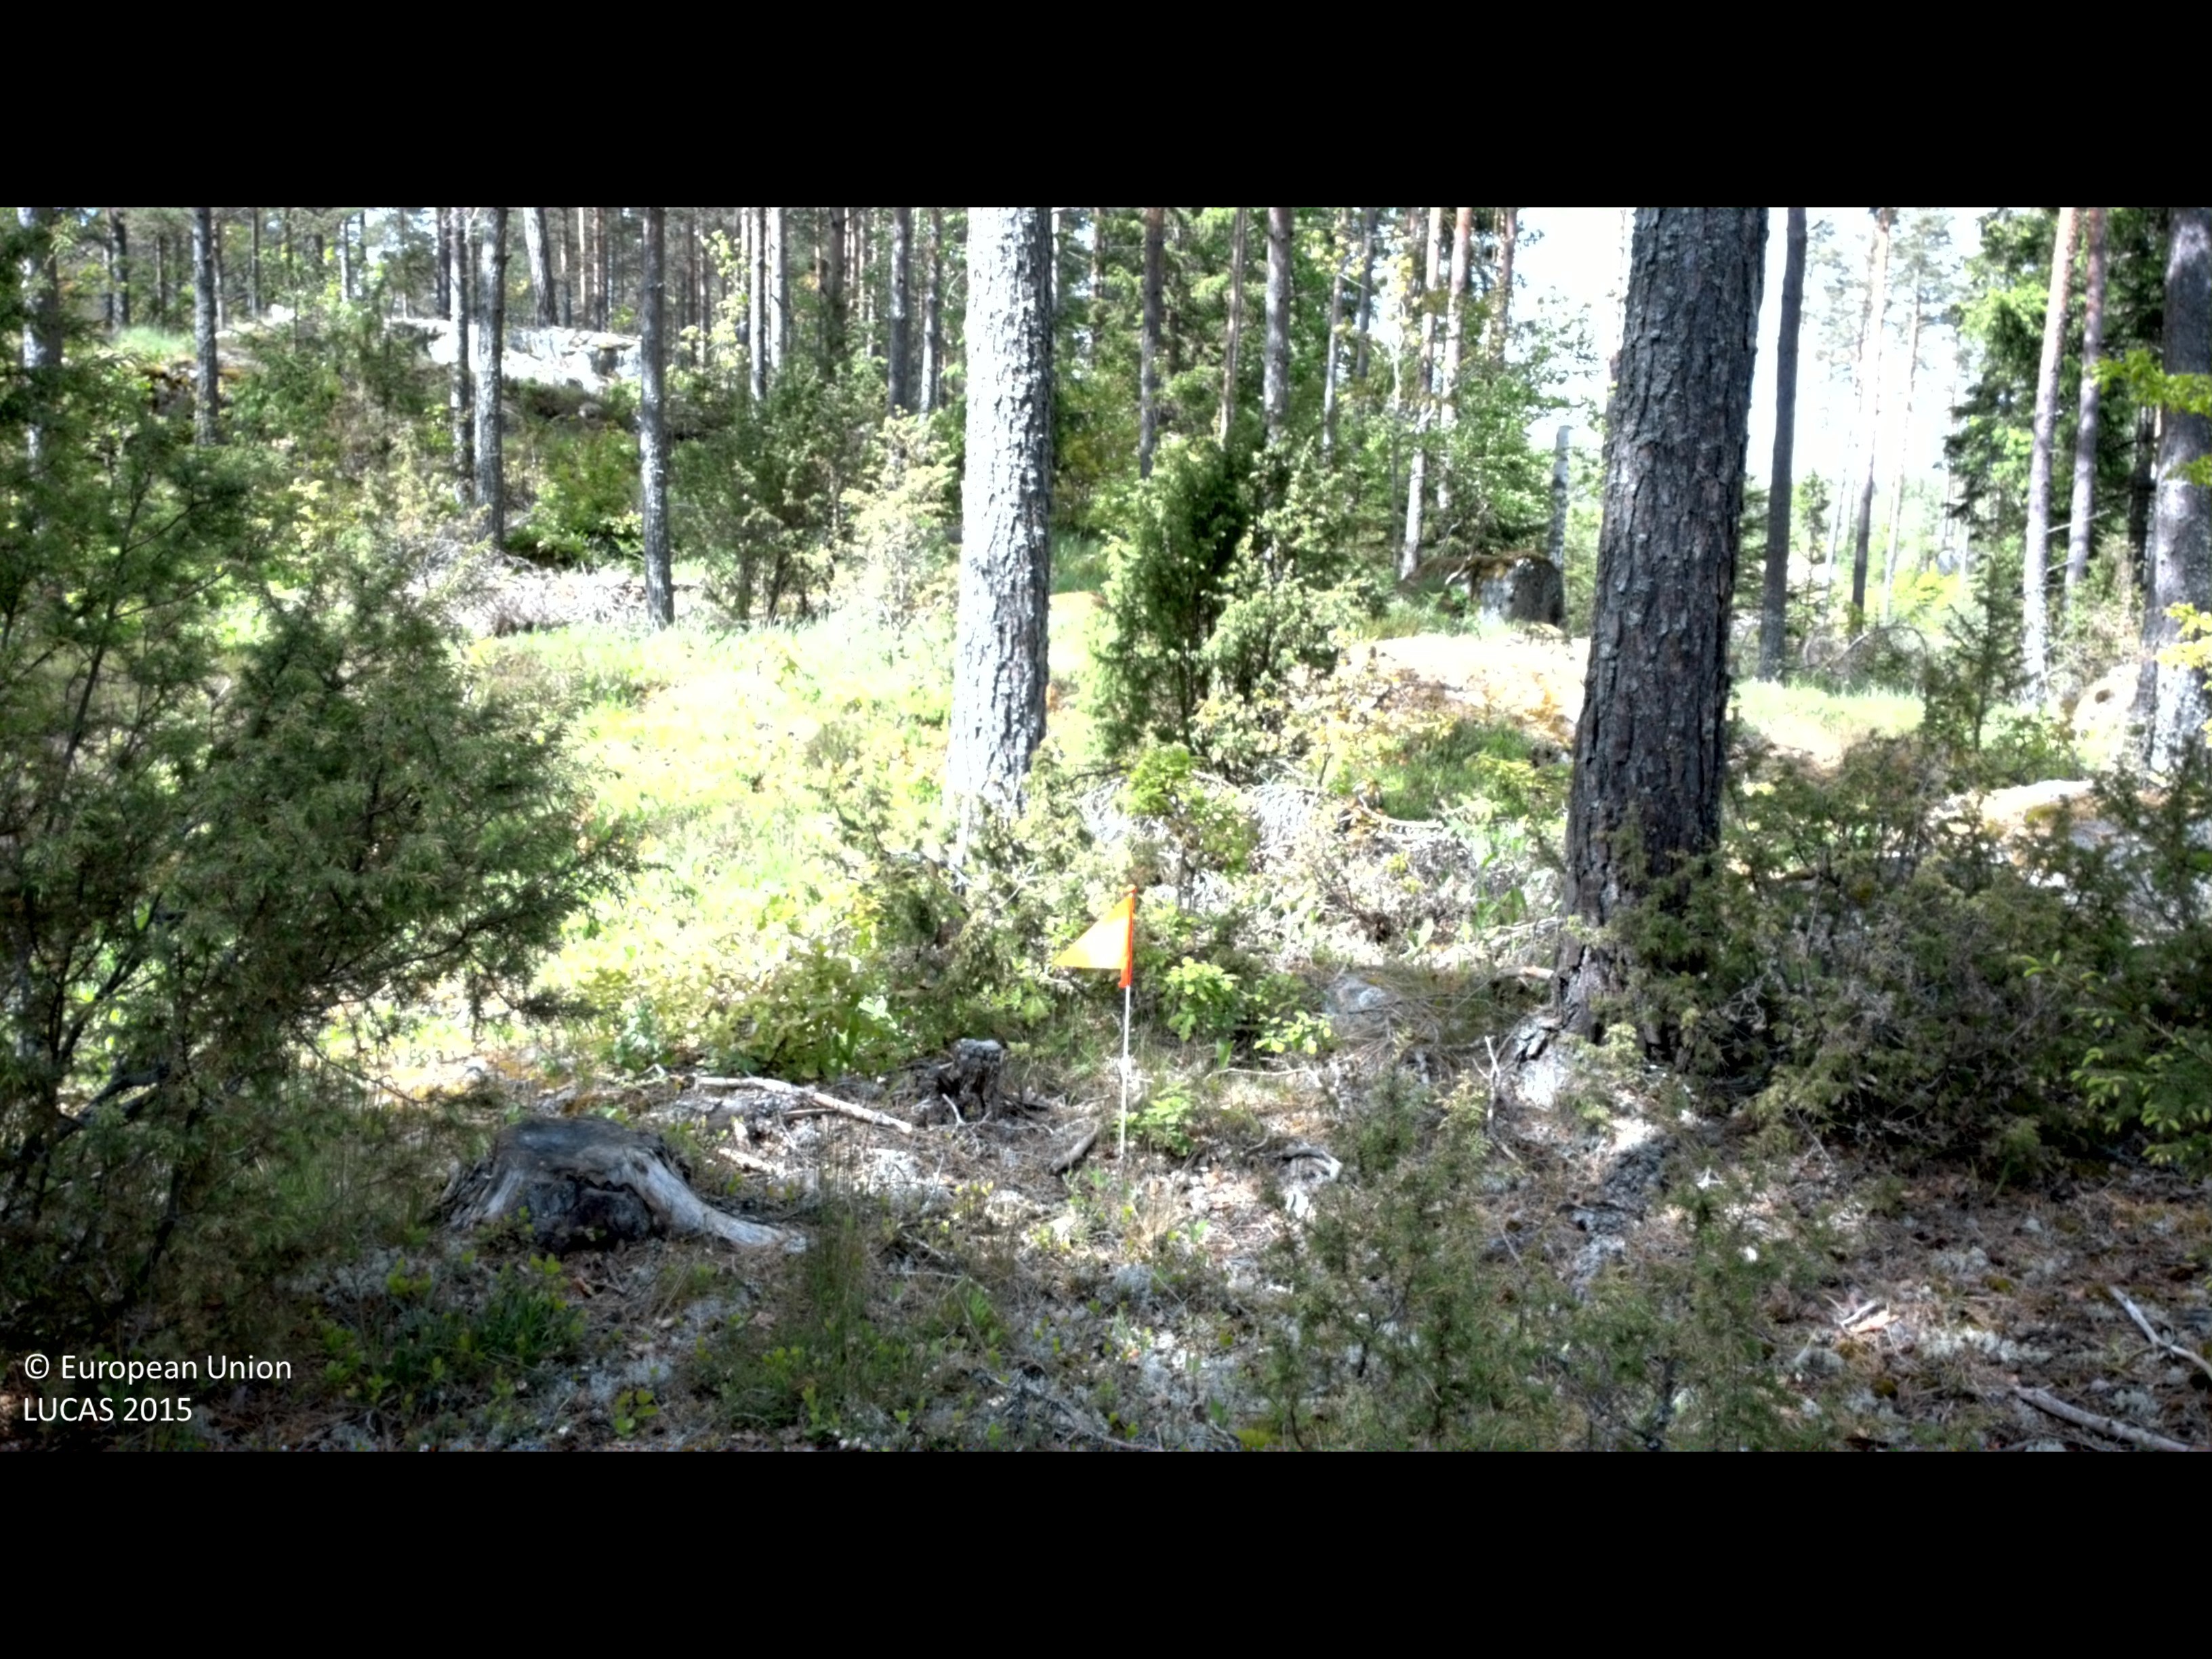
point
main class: Woodland
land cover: Pine dominated coniferous woodland
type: boreal forest
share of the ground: 50 - 75 %
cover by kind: coniferous forest trees 50 %, lichens and mosses 20 %, shrubs 15 %, herbaceous plants 10 %, broadleaved forest trees 5 %
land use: Forestry
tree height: > 5 m
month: May
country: SE
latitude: 57.5291
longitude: 16.3281
